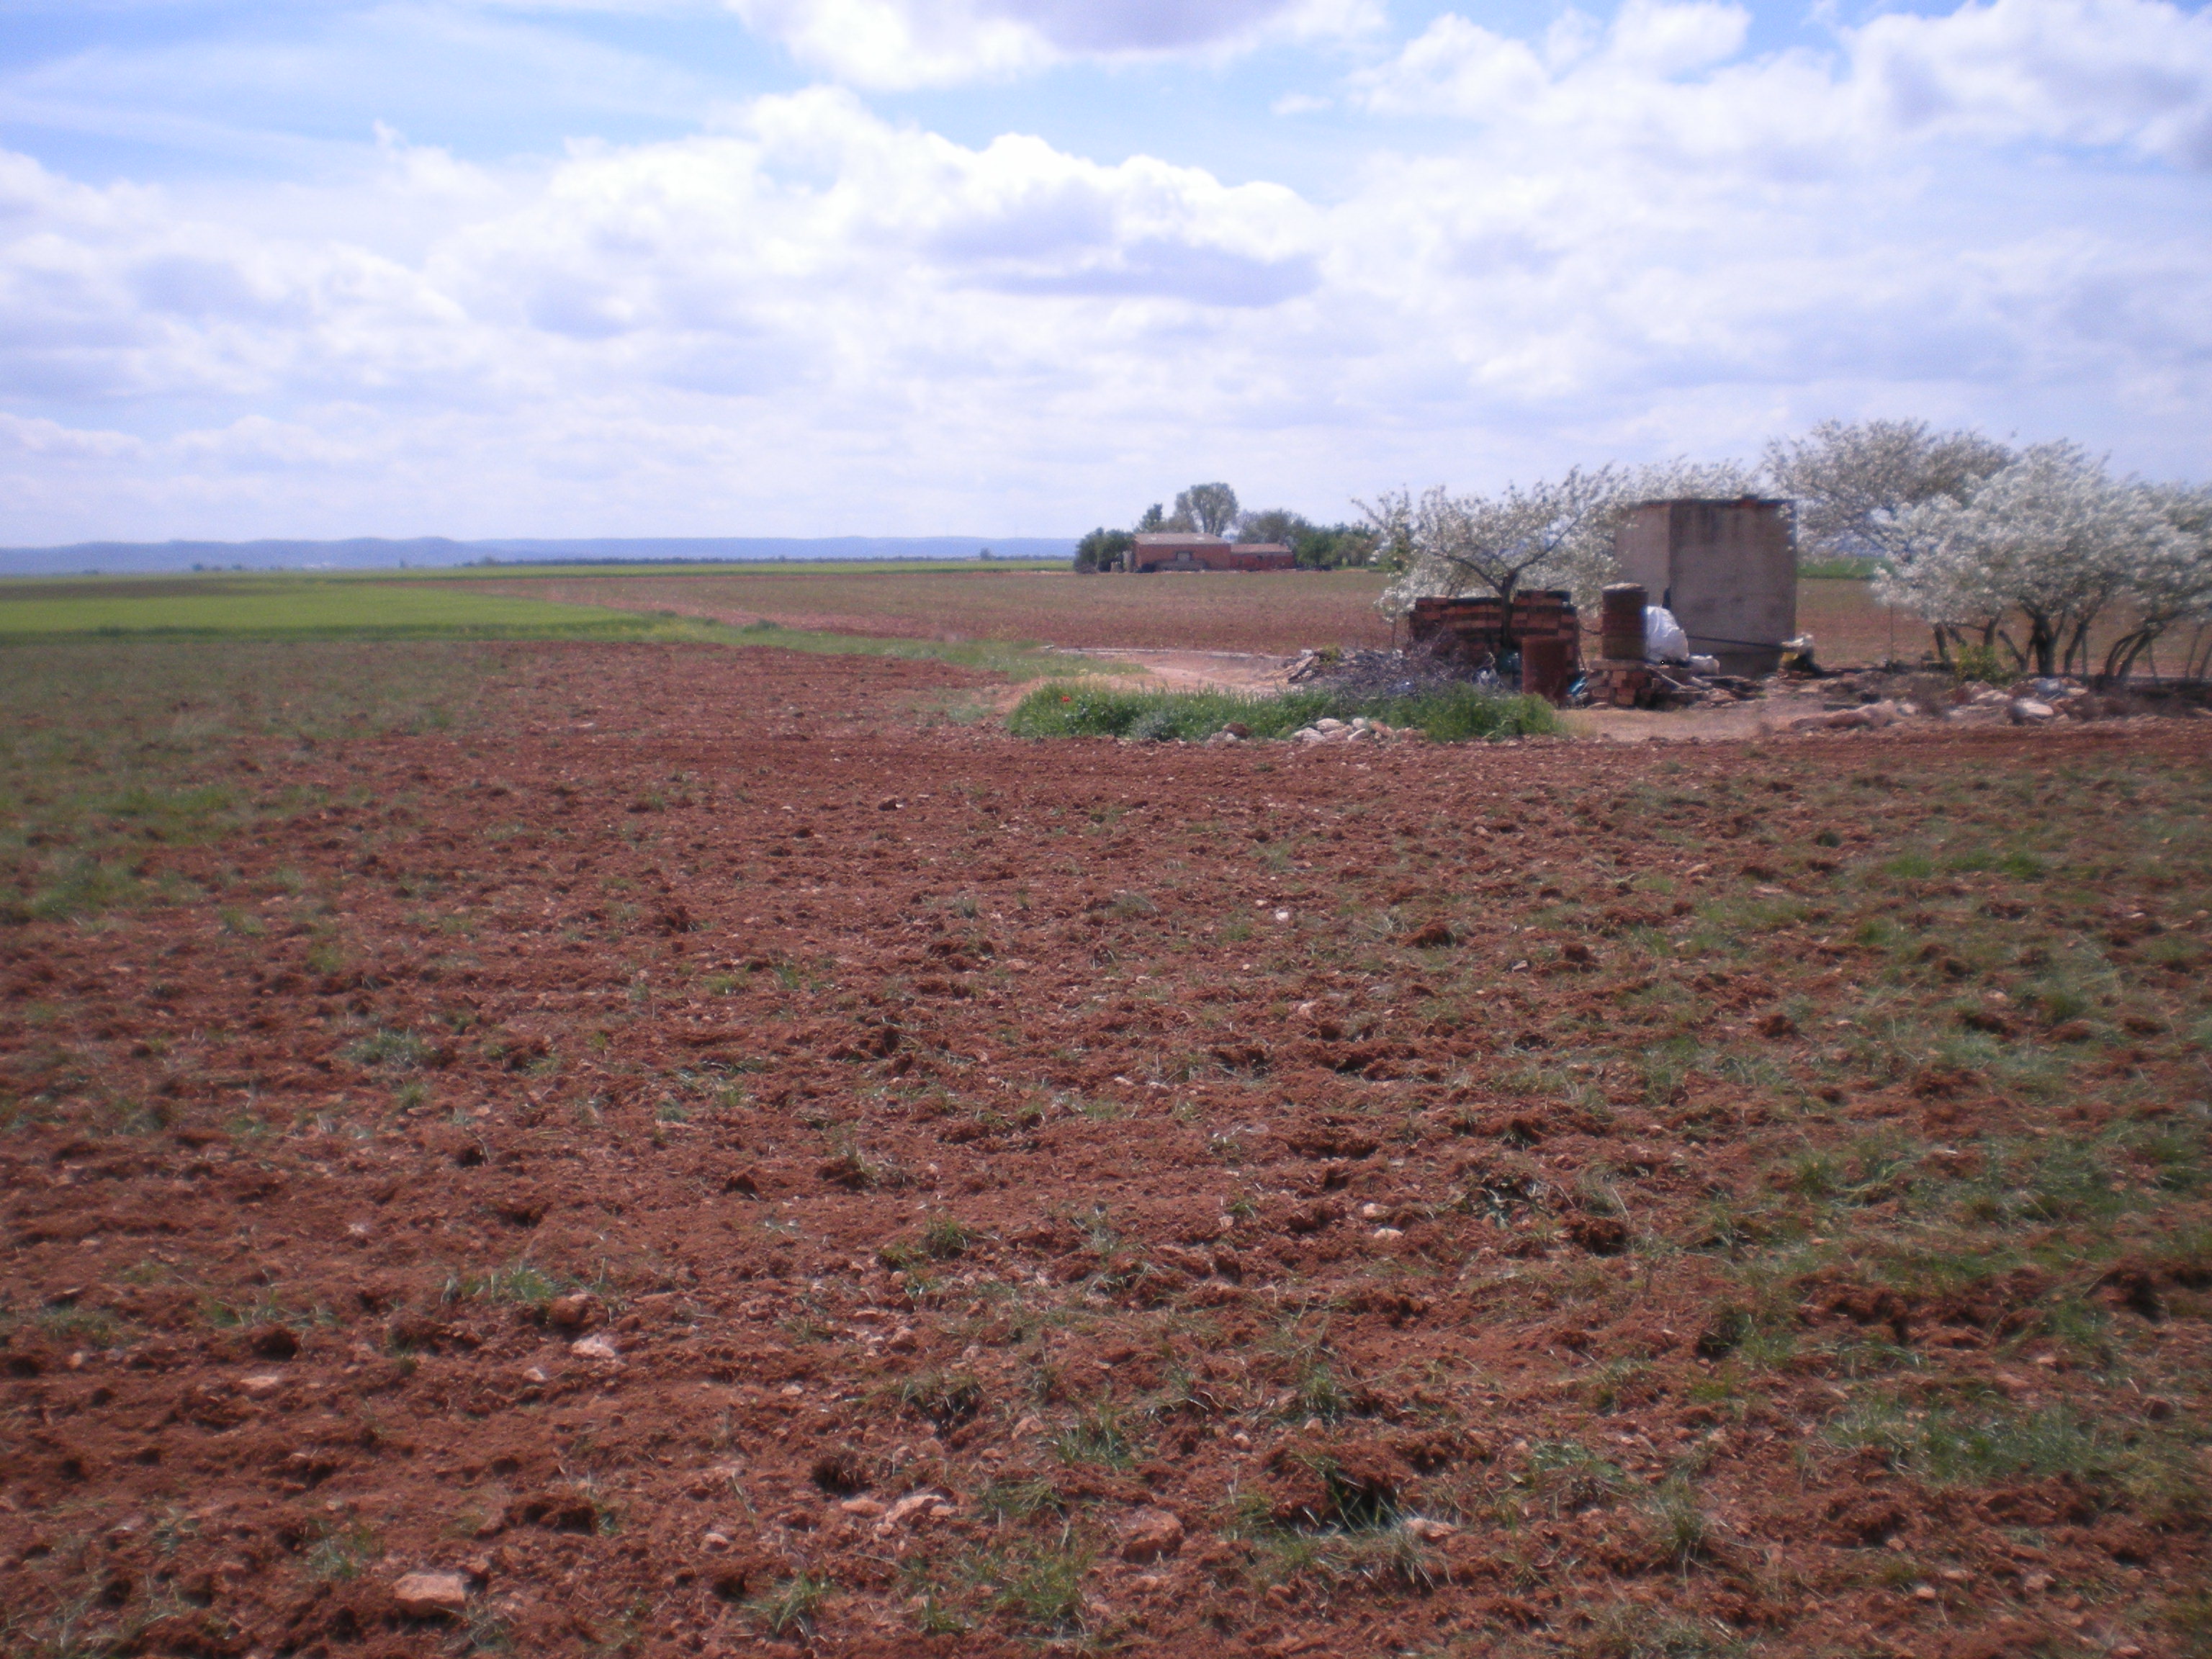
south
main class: Grassland
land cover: Spontaneously vegetated surfaces
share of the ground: 25 - 50 %
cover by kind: unconsolidated bare surface 70 %, herbaceous plants 30 %
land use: Fallow land
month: April
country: ES
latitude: 39.0028
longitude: -3.6079
